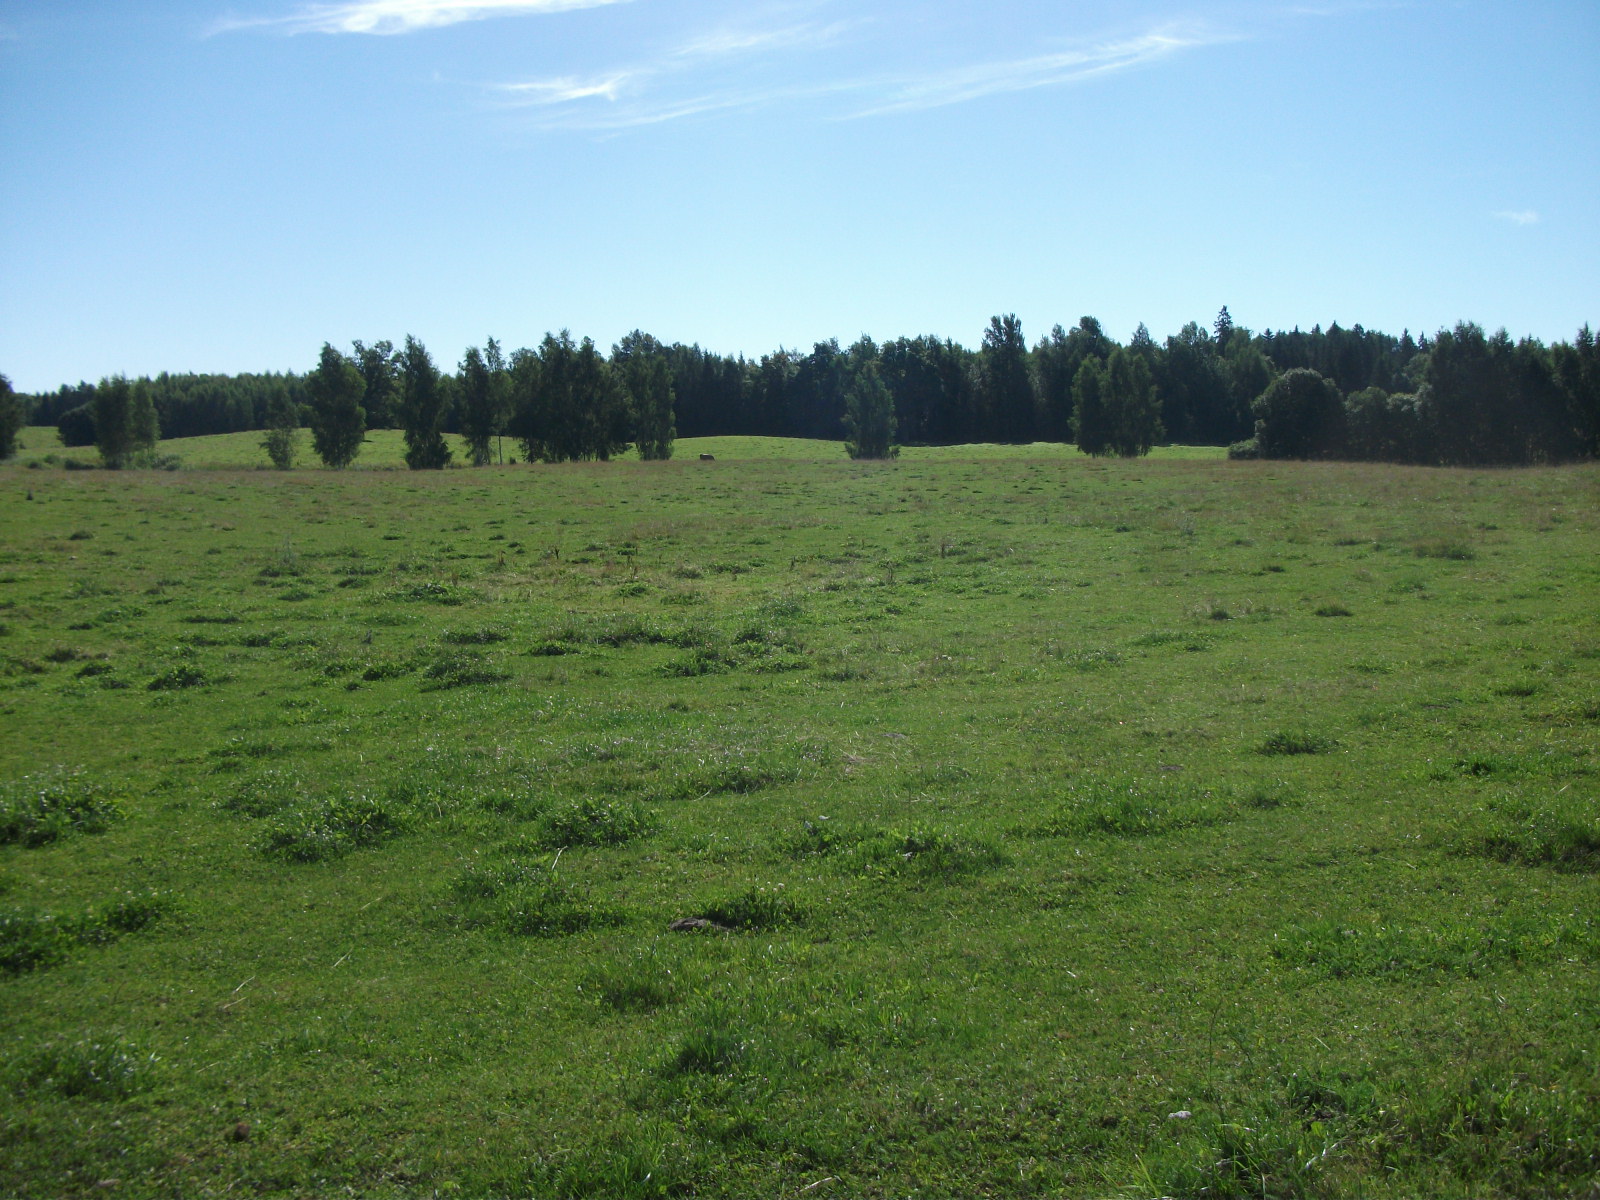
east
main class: Grassland
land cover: Grassland without tree/shrub cover
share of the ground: > 75 %
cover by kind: herbaceous plants 100 %
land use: Agriculture (excluding fallow land and kitchen gardens)
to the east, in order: Grassland without tree/shrub cover; Electric lines; Grassland without tree/shrub cover; Abandoned hedges; Rivers and streams; Abandoned hedges; Grassland without tree/shrub cover
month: August
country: LV
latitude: 57.0347
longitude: 26.4062
